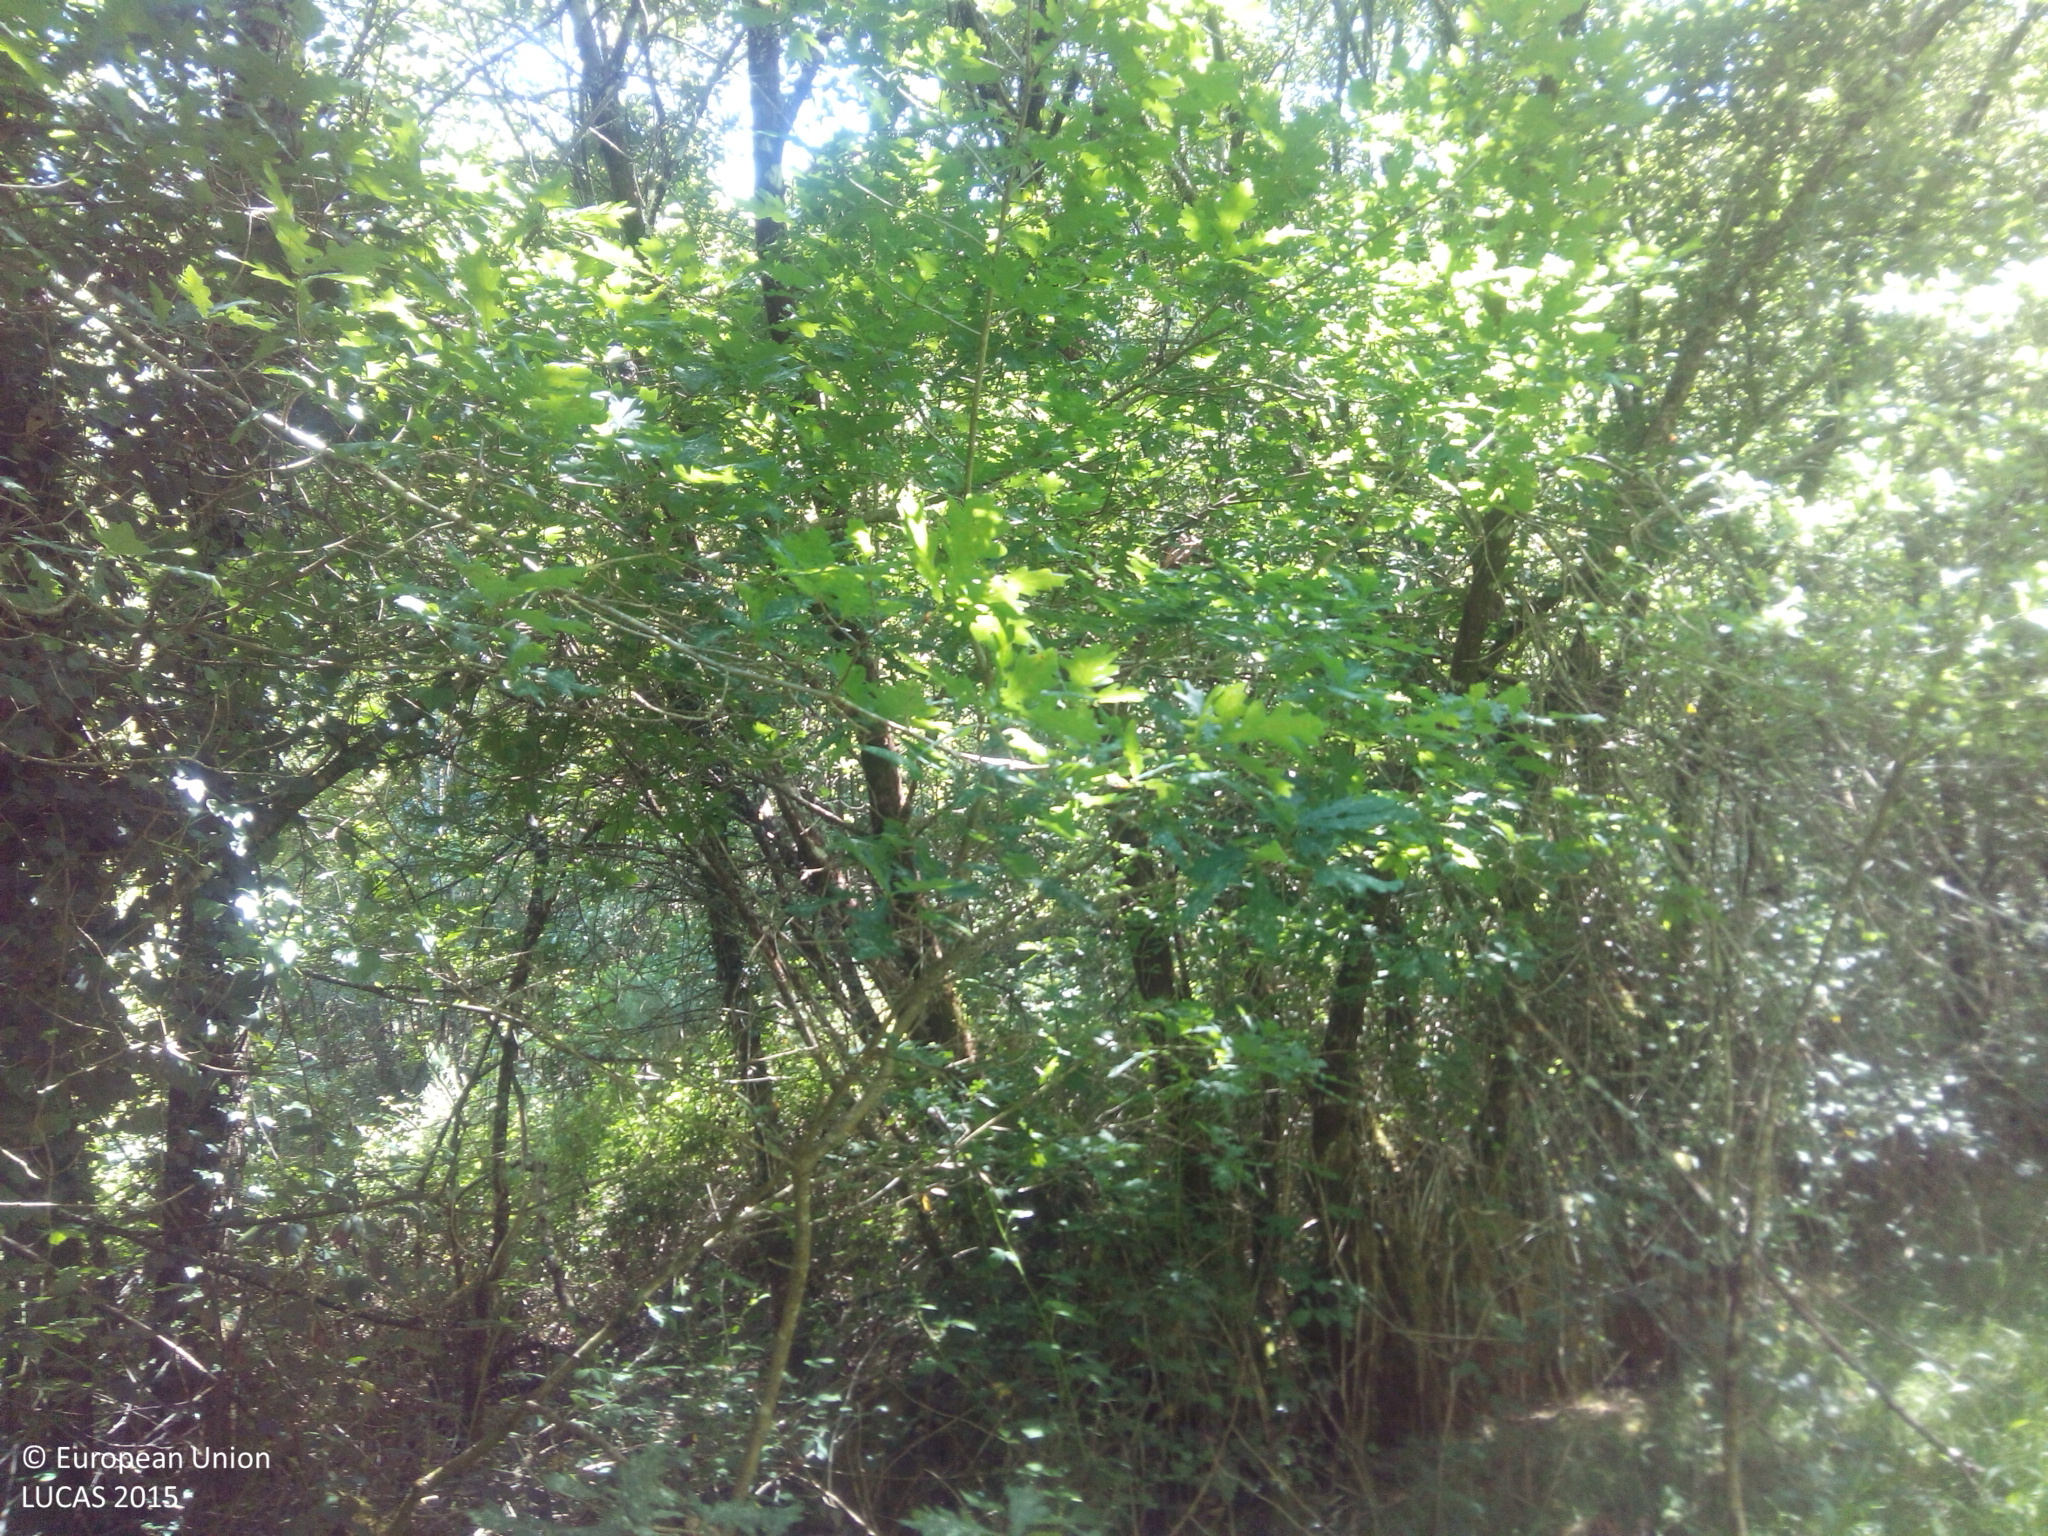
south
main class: Woodland
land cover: Broadleaved woodland
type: acidophilous oak and oak-birch forest
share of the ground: > 75 %
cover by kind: broadleaved forest trees 100 %
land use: Forestry
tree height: > 5 m
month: June
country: ES
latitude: 42.4793
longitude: -8.3272
